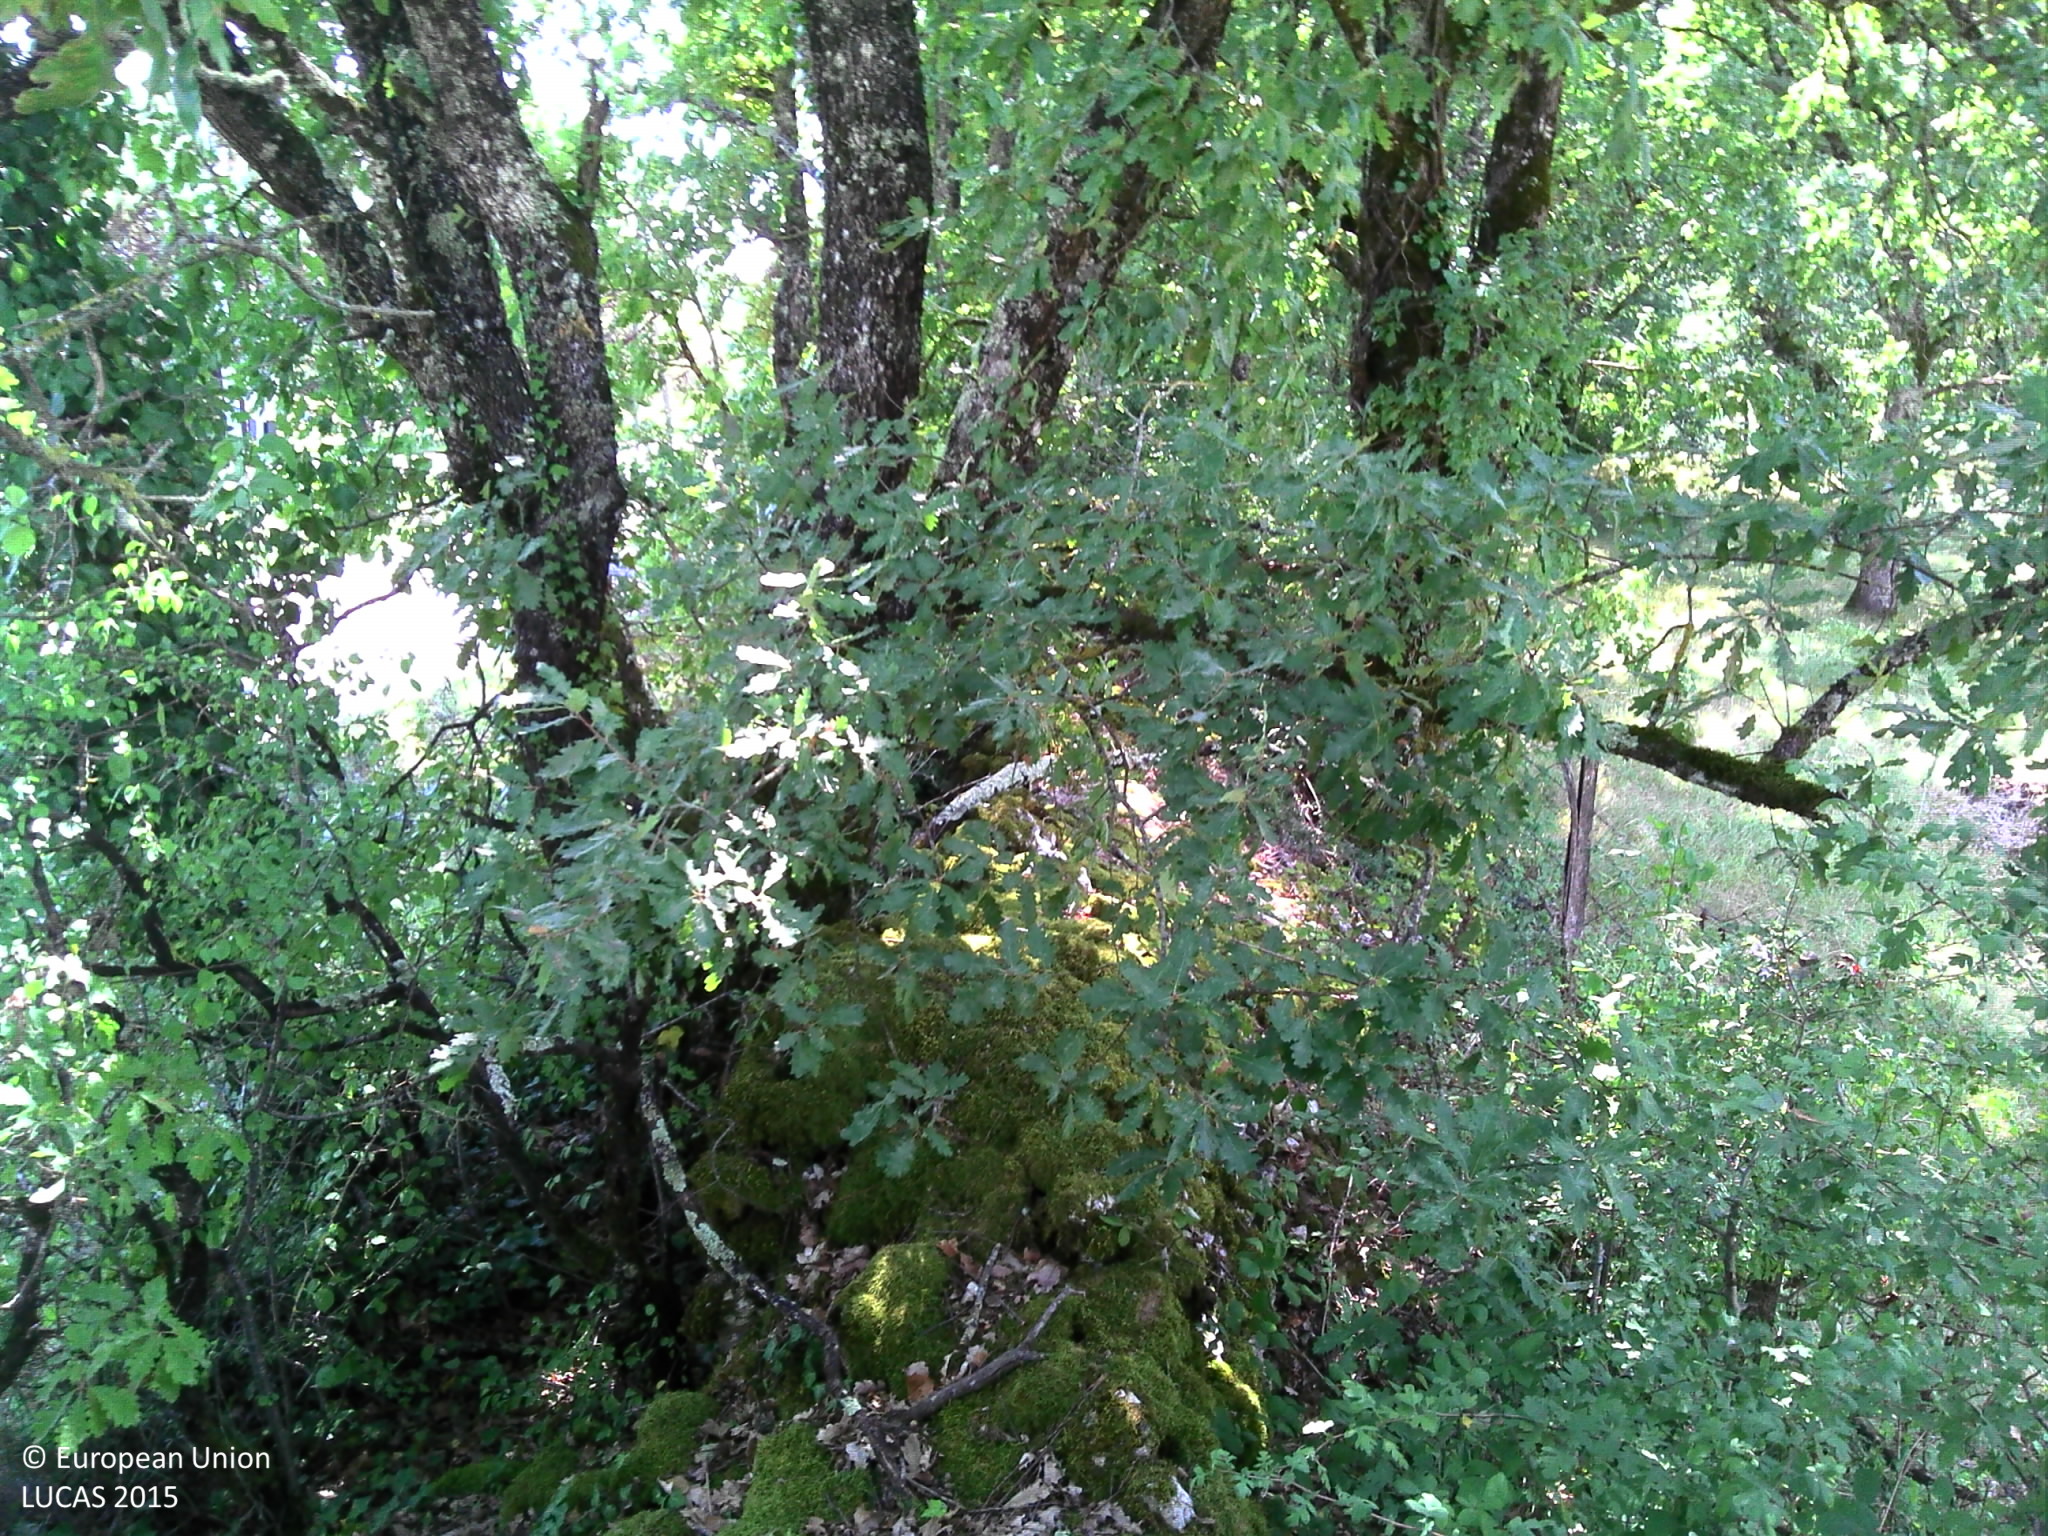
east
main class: Grassland
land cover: Spontaneously vegetated surfaces
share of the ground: 10 - 25 %
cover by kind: consolidated bare surface 75 %, herbaceous plants 25 %
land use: Agriculture (excluding fallow land and kitchen gardens)
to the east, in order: Spontaneously vegetated surfaces; Fences; Abandoned hedges; Ditches and canals; Paved roads, cycling and walking lanes; Electric lines; Ditches and canals; Grassland without tree/shrub cover; Artificial constructions in urban areas; Electric lines; Ditches and canals; Paved roads, cycling and walking lanes; Ditches and canals; Electric lines; Grassland without tree/shrub cover; Broadleaved woodland; Tracks
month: August
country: FR
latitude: 44.2547
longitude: 1.4952
